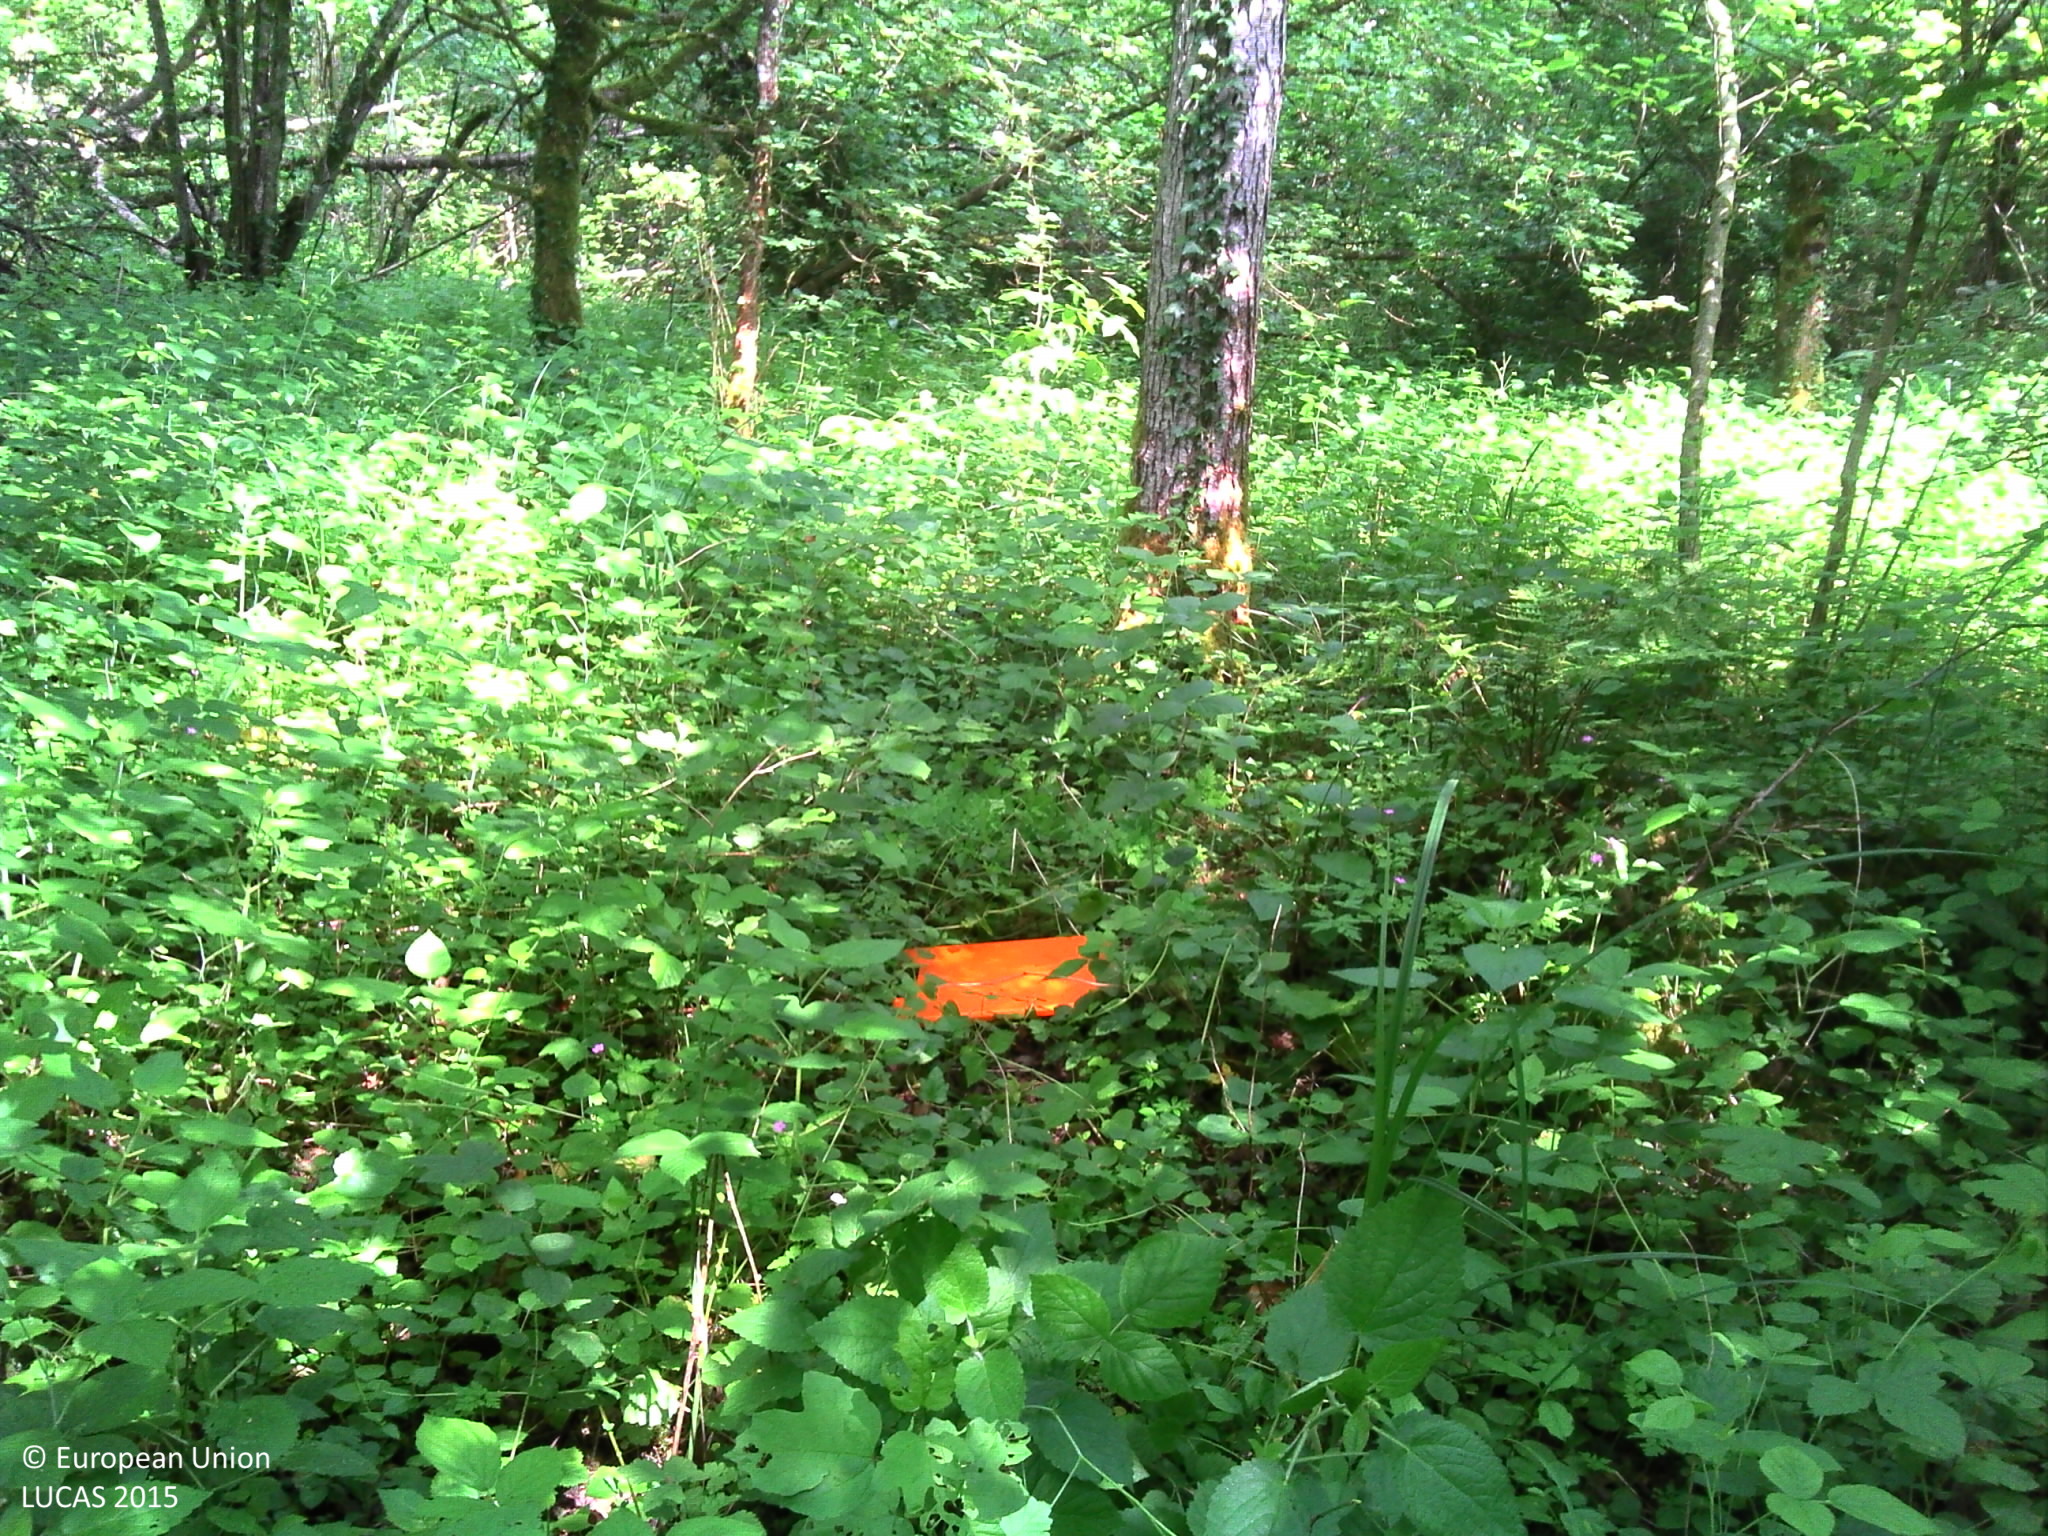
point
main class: Woodland
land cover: Broadleaved woodland
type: beech forest
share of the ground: > 75 %
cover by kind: broadleaved forest trees 90 %, herbaceous plants 10 %
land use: Forestry
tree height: > 5 m
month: June
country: FR
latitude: 47.9045
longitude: 6.1614
